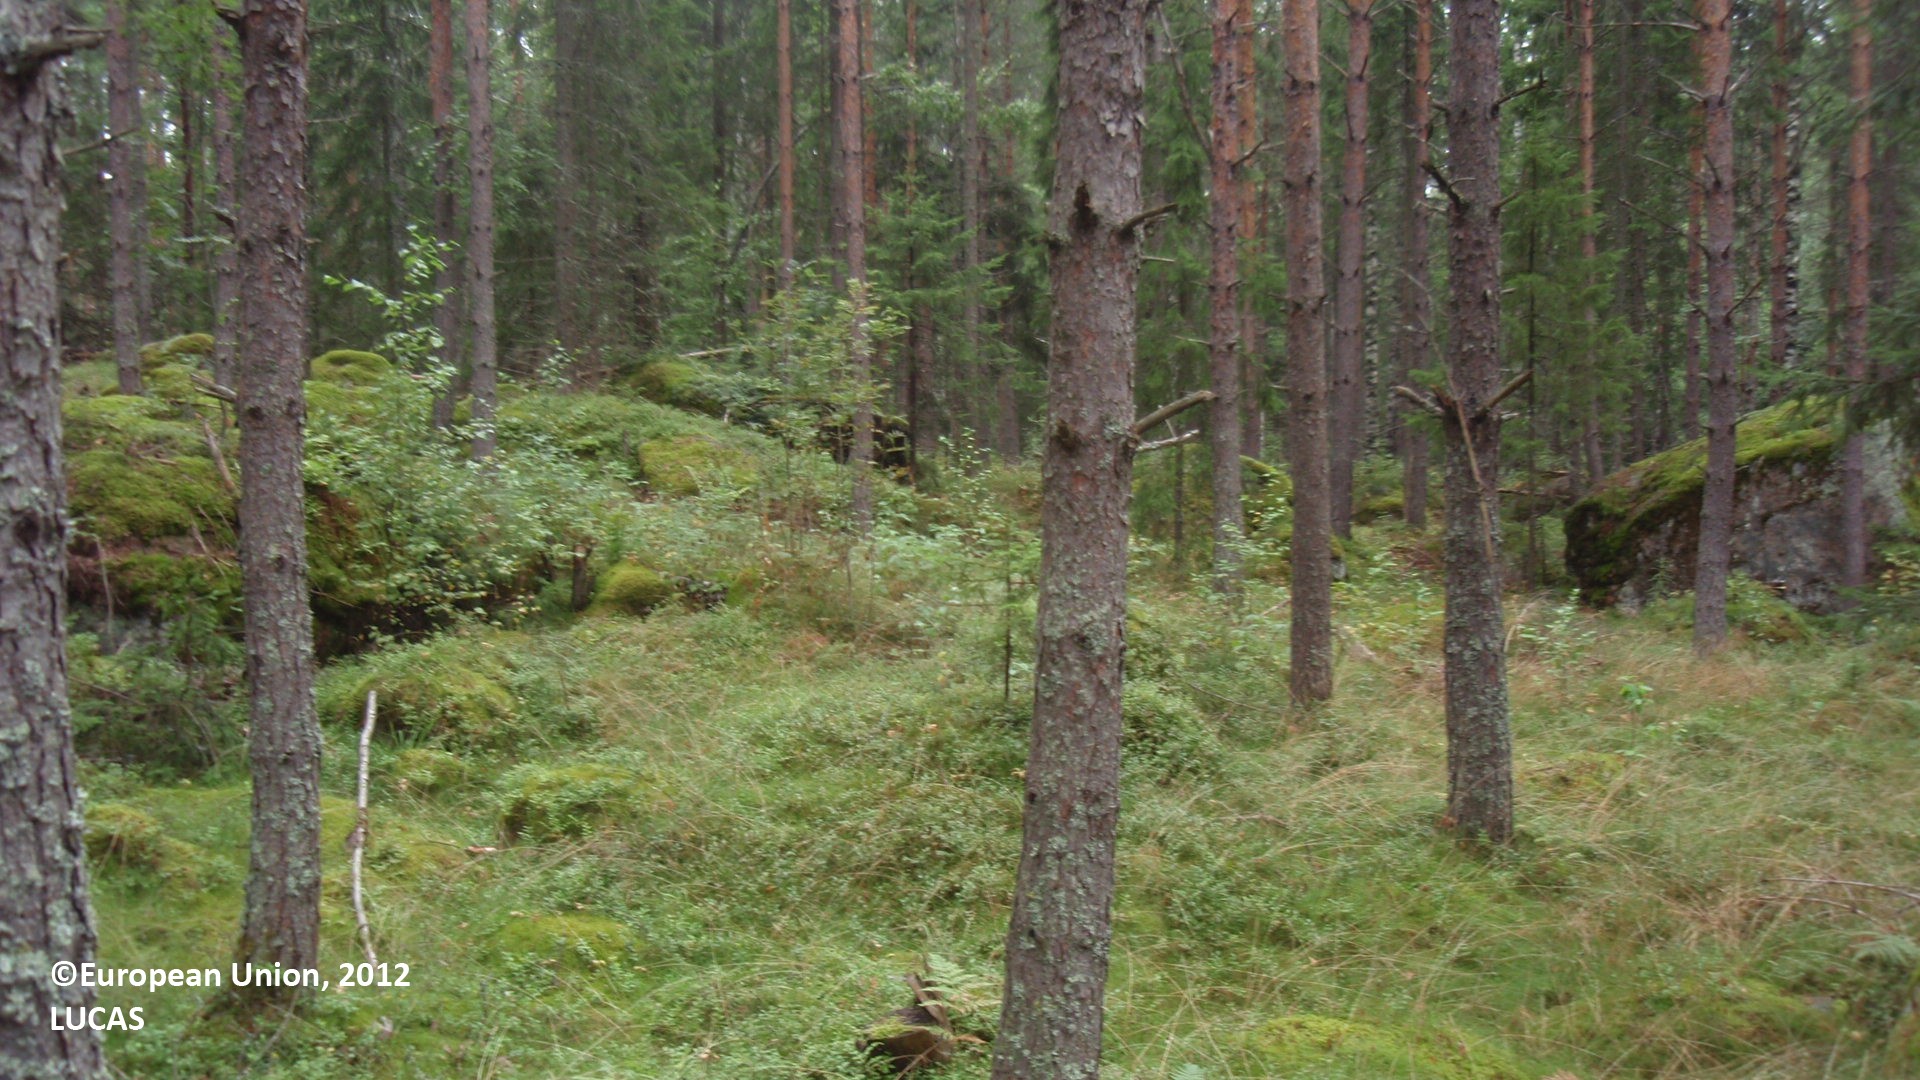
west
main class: Woodland
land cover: Pine dominated mixed woodland
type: boreal forest
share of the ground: 50 - 75 %
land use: Forestry
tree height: > 5 m
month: August
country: FI
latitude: 60.6020
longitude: 26.6510
